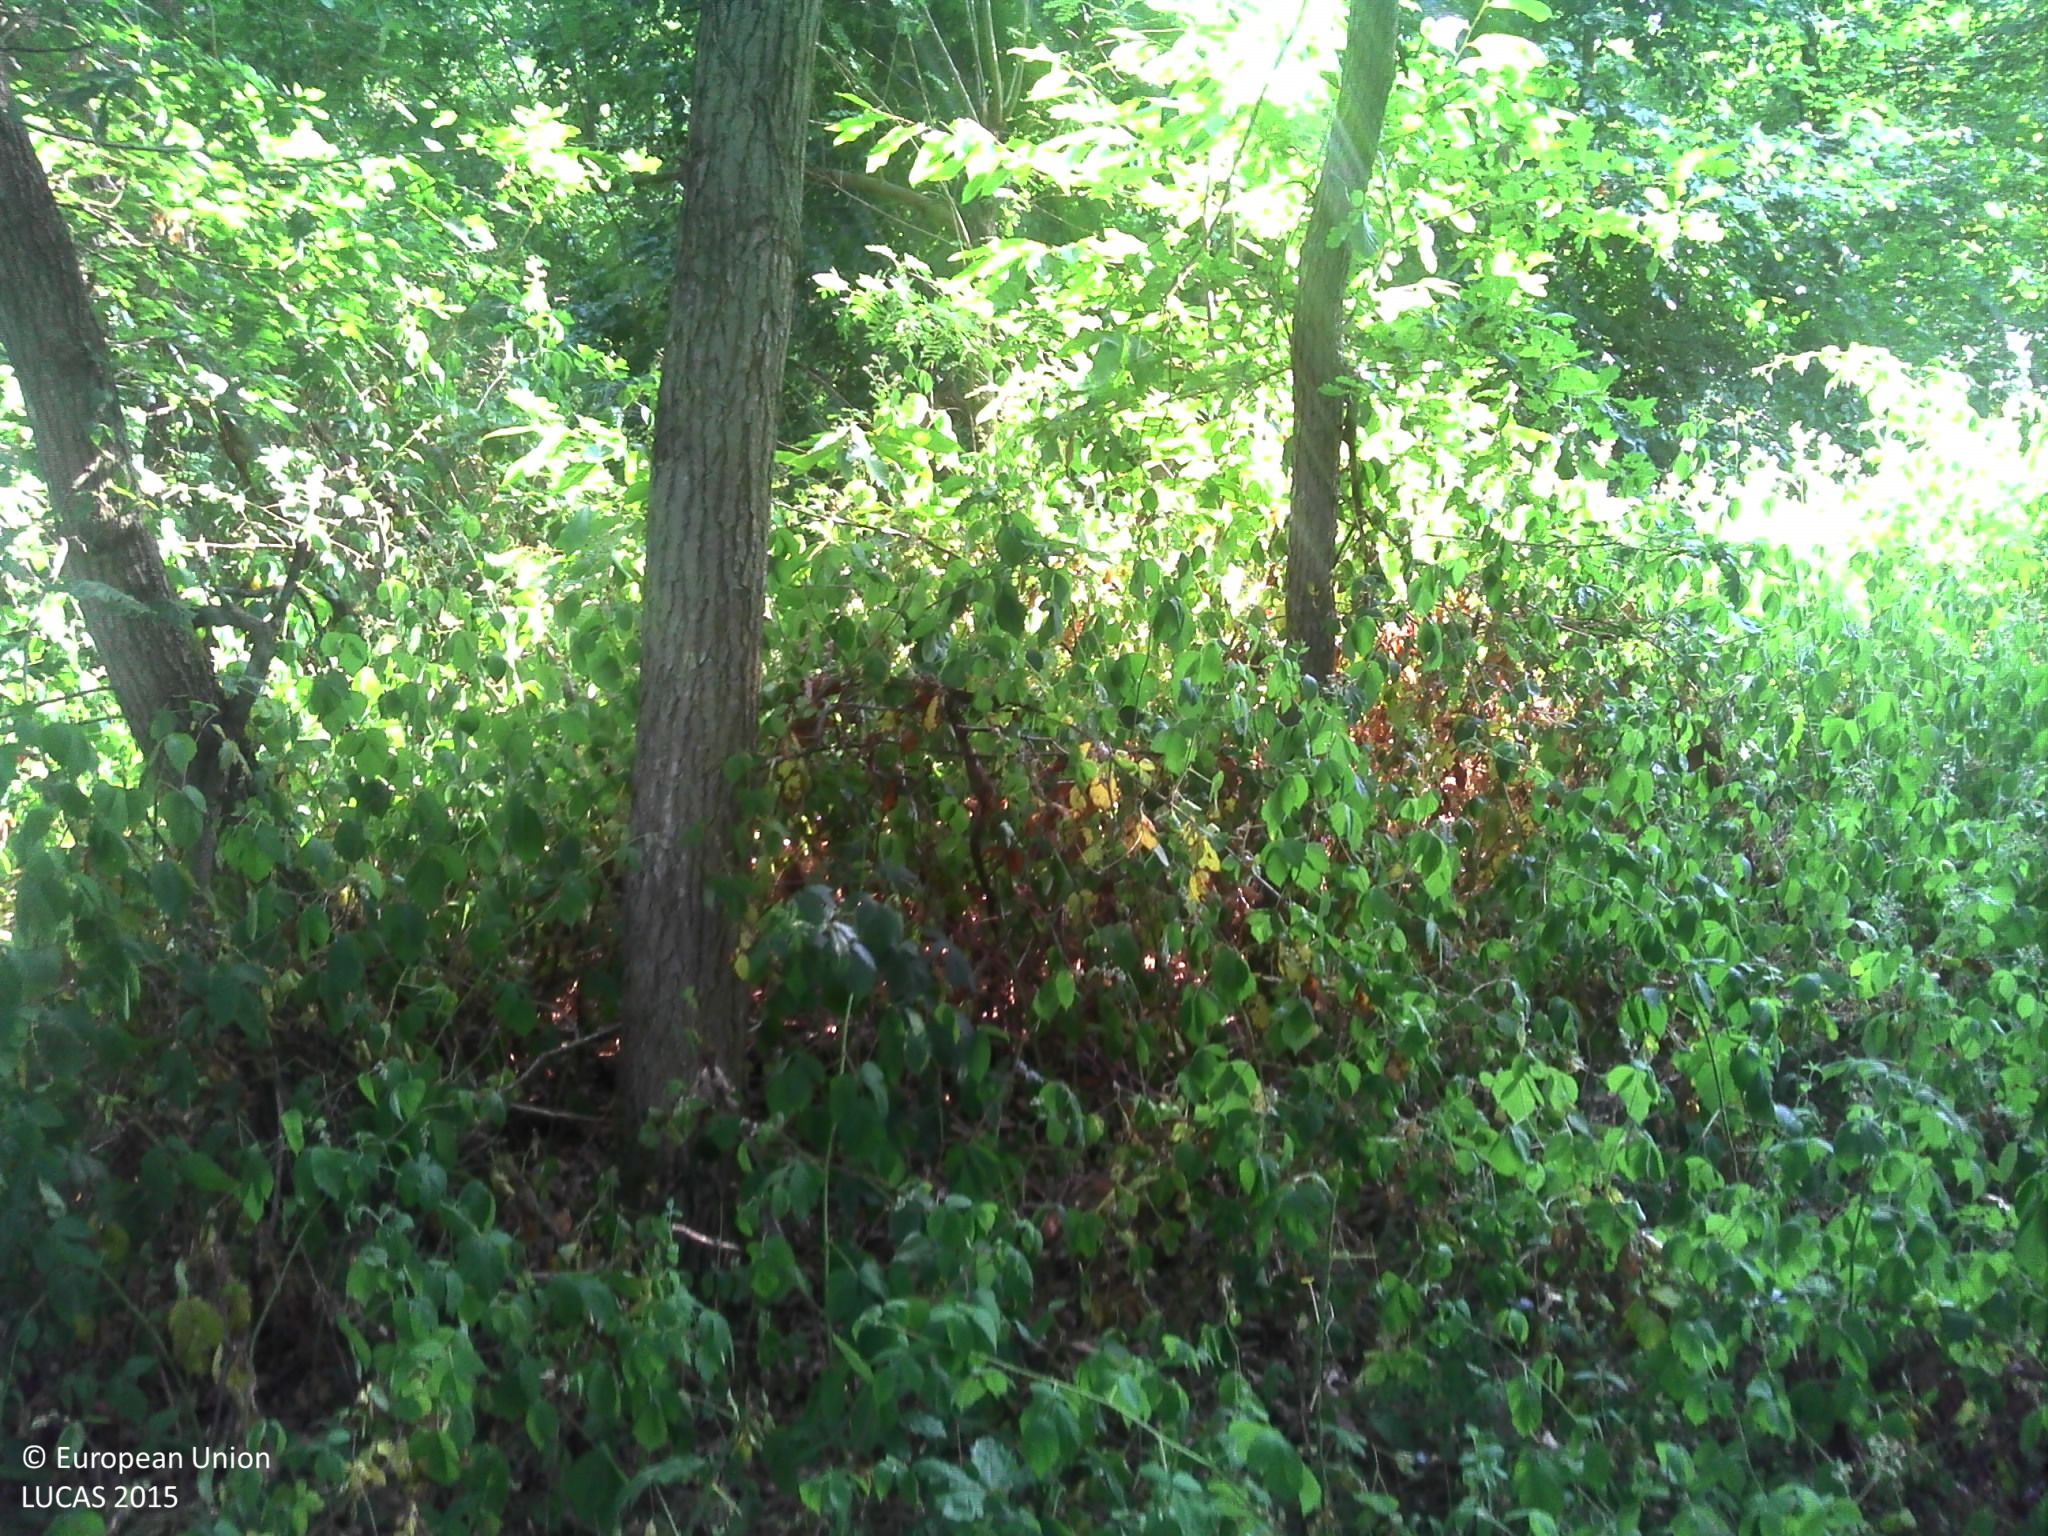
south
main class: Woodland
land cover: Broadleaved woodland
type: acidophilous oak and oak-birch forest
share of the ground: > 75 %
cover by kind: broadleaved forest trees 60 %, herbaceous plants 30 %, lichens and mosses 10 %
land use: Forestry
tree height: > 5 m
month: July
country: FR
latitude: 48.7227
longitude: 1.2128
